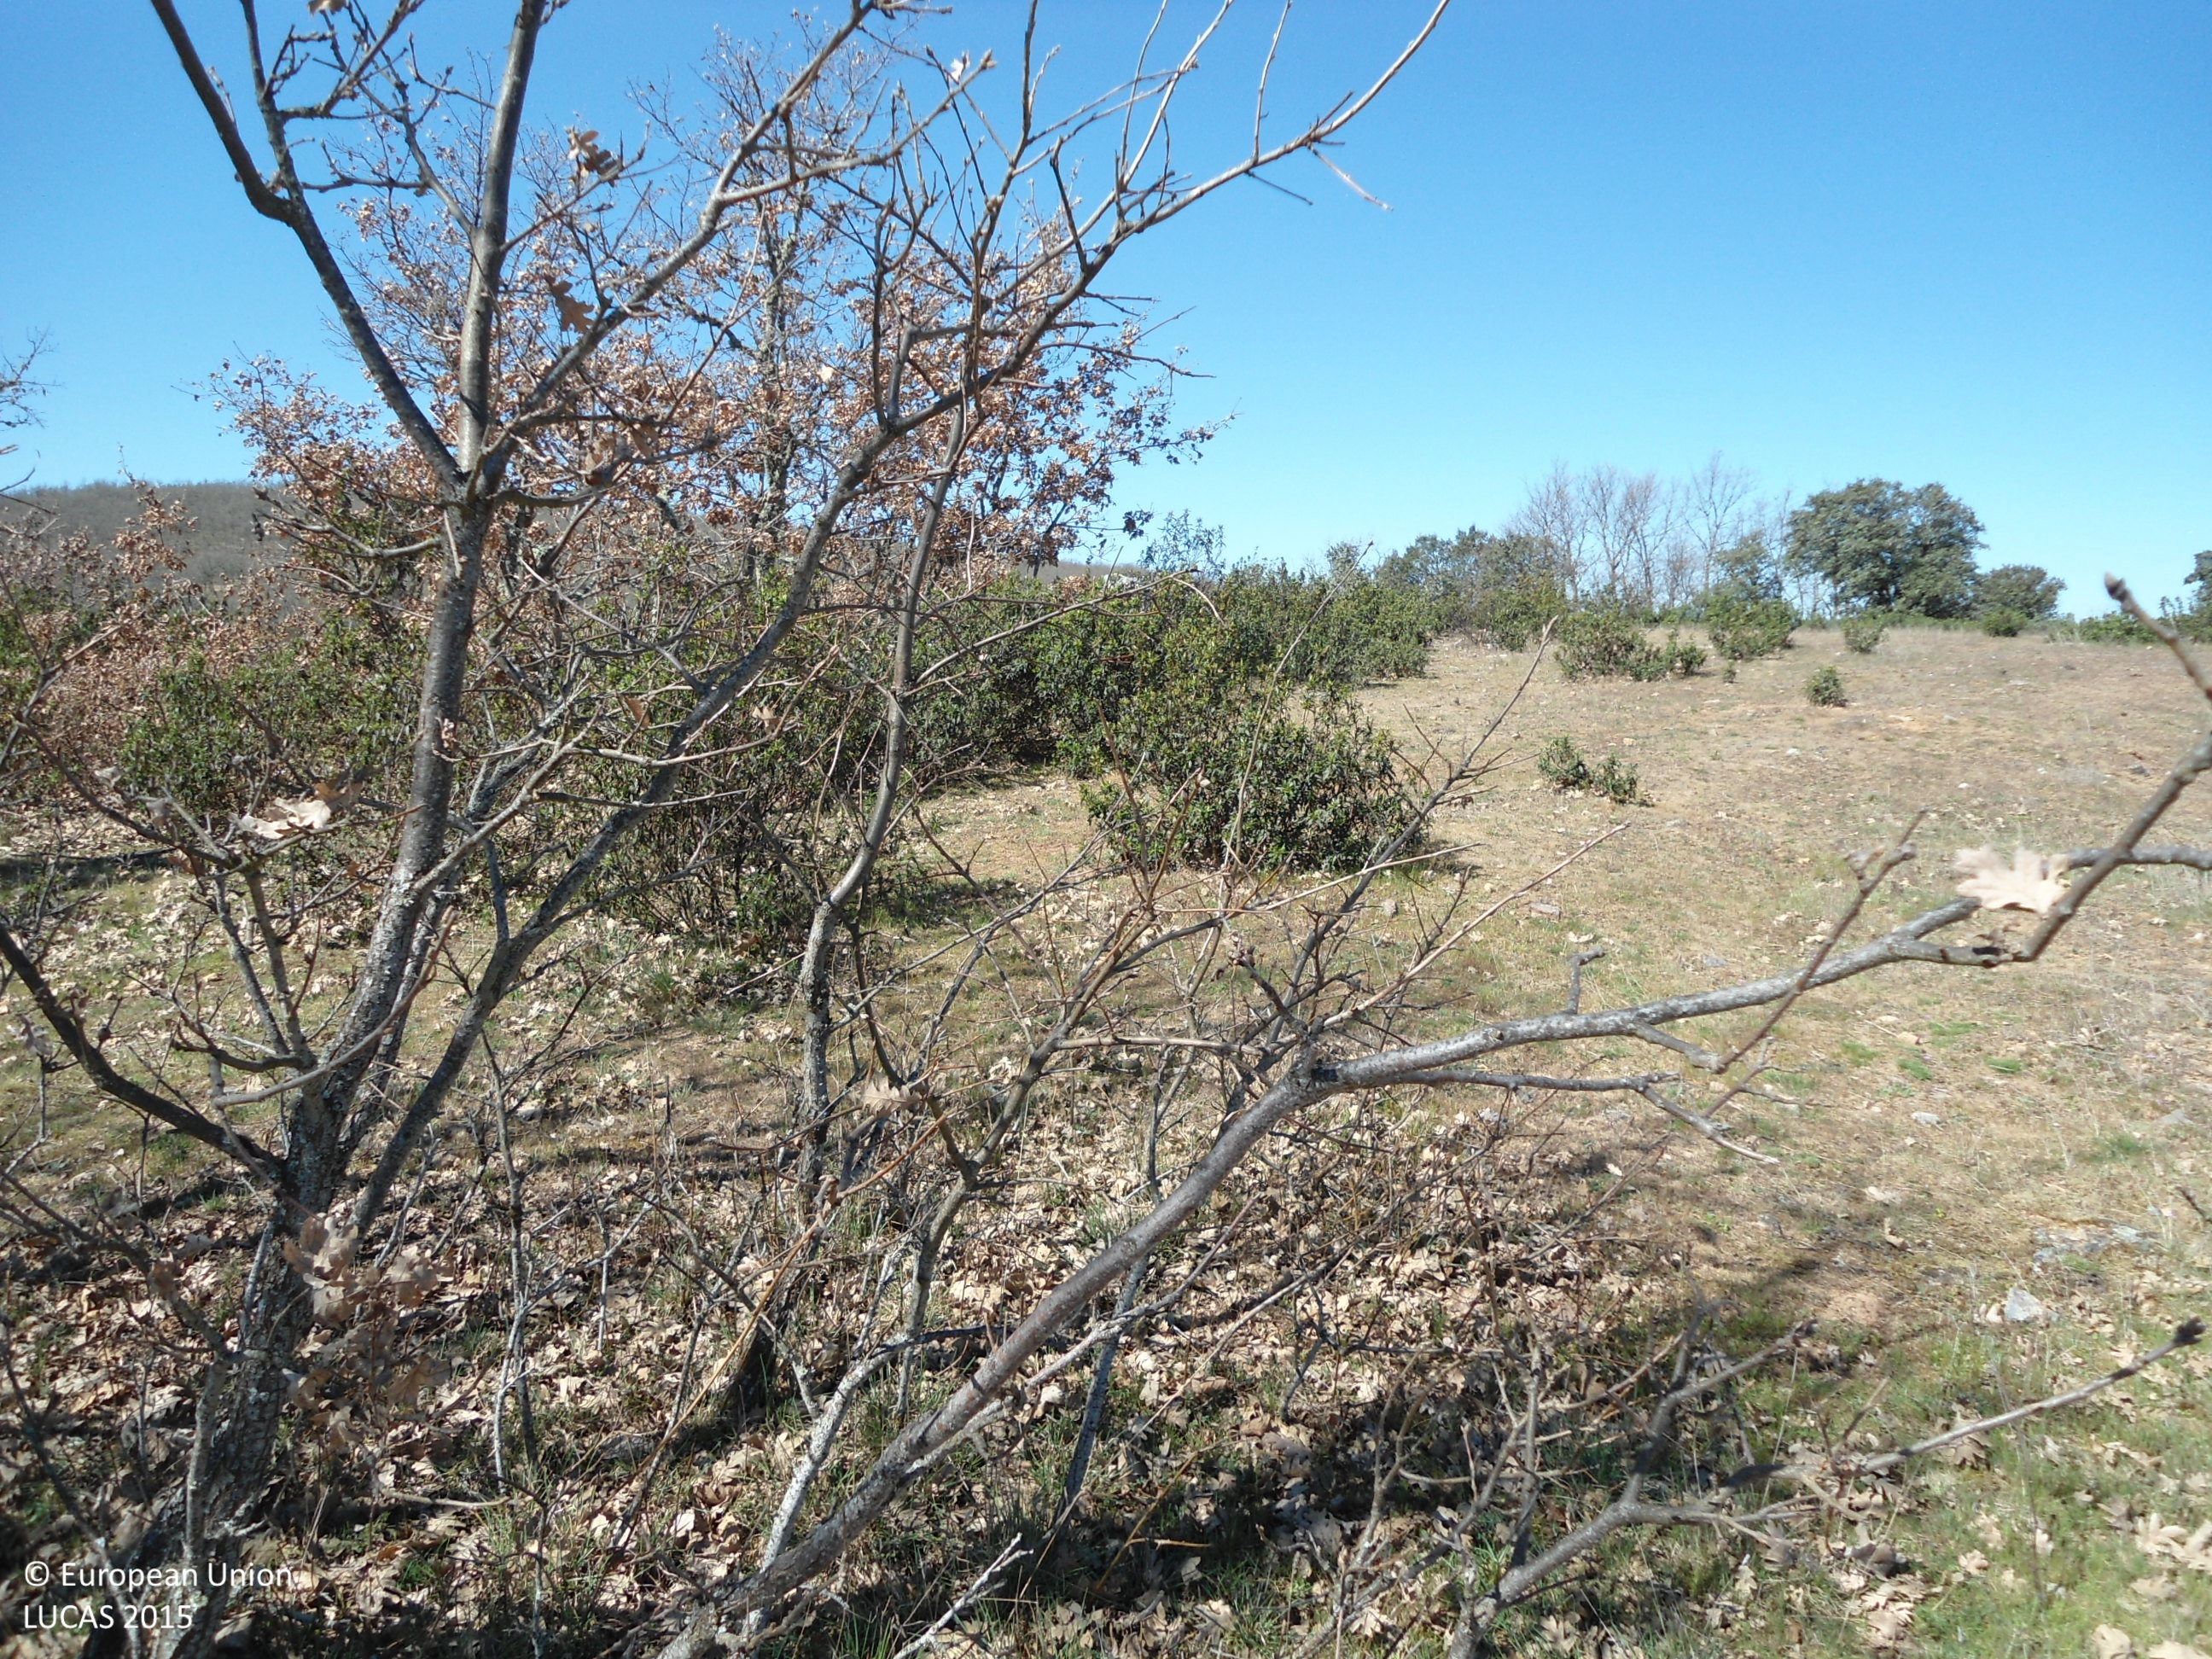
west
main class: Grassland
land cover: Spontaneously vegetated surfaces
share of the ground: 50 - 75 %
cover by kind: herbaceous plants 85 %, unconsolidated bare surface 10 %, shrubs 5 %
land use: Agriculture (excluding fallow land and kitchen gardens)
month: April
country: ES
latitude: 41.7364
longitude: -6.2477
